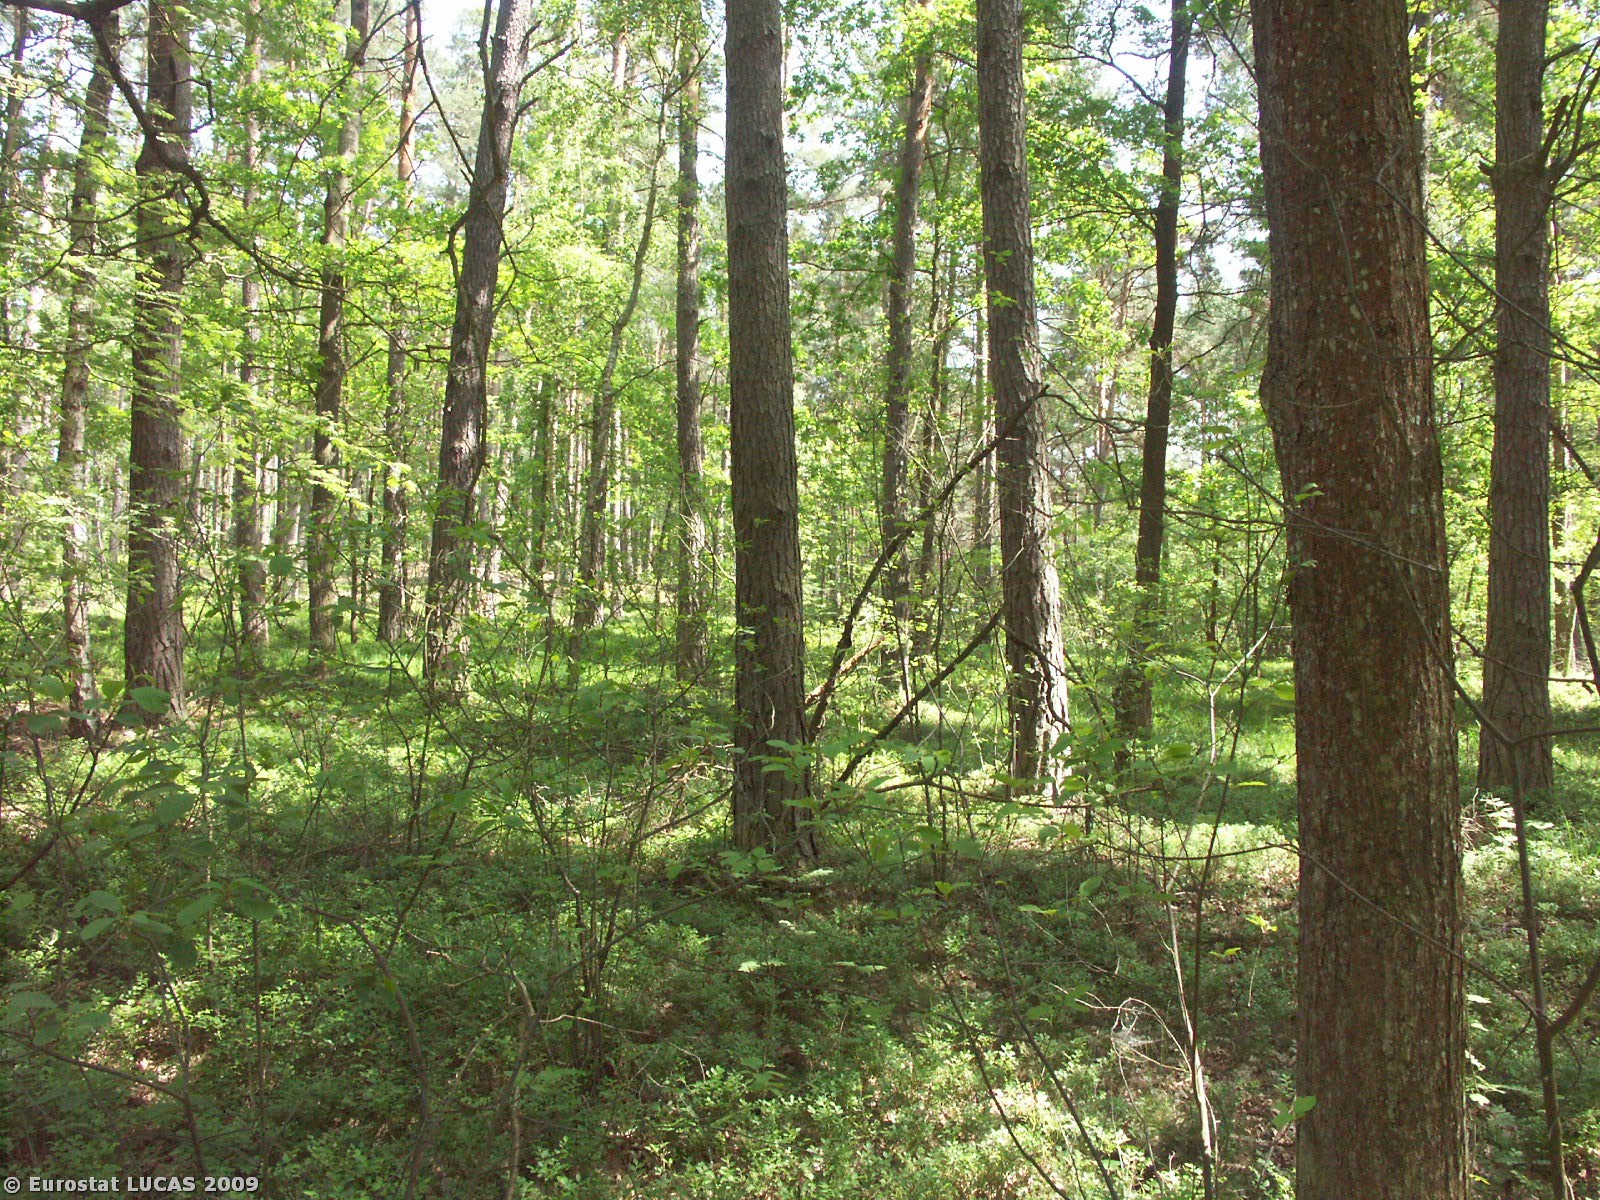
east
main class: Woodland
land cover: Mixed woodland
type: hemiboreal forest and nemoral coniferous forest and mixed broadleaved-coniferous forest
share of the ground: > 75 %
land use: Forestry
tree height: > 5 m
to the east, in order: Mixed woodland; Tracks; Mixed woodland; Coniferous woodland; Tracks; Coniferous woodland; Tracks; Grassland with sparse tree/shrub cover; Broadleaved woodland
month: May
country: CZ
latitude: 49.0259
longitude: 14.6650
